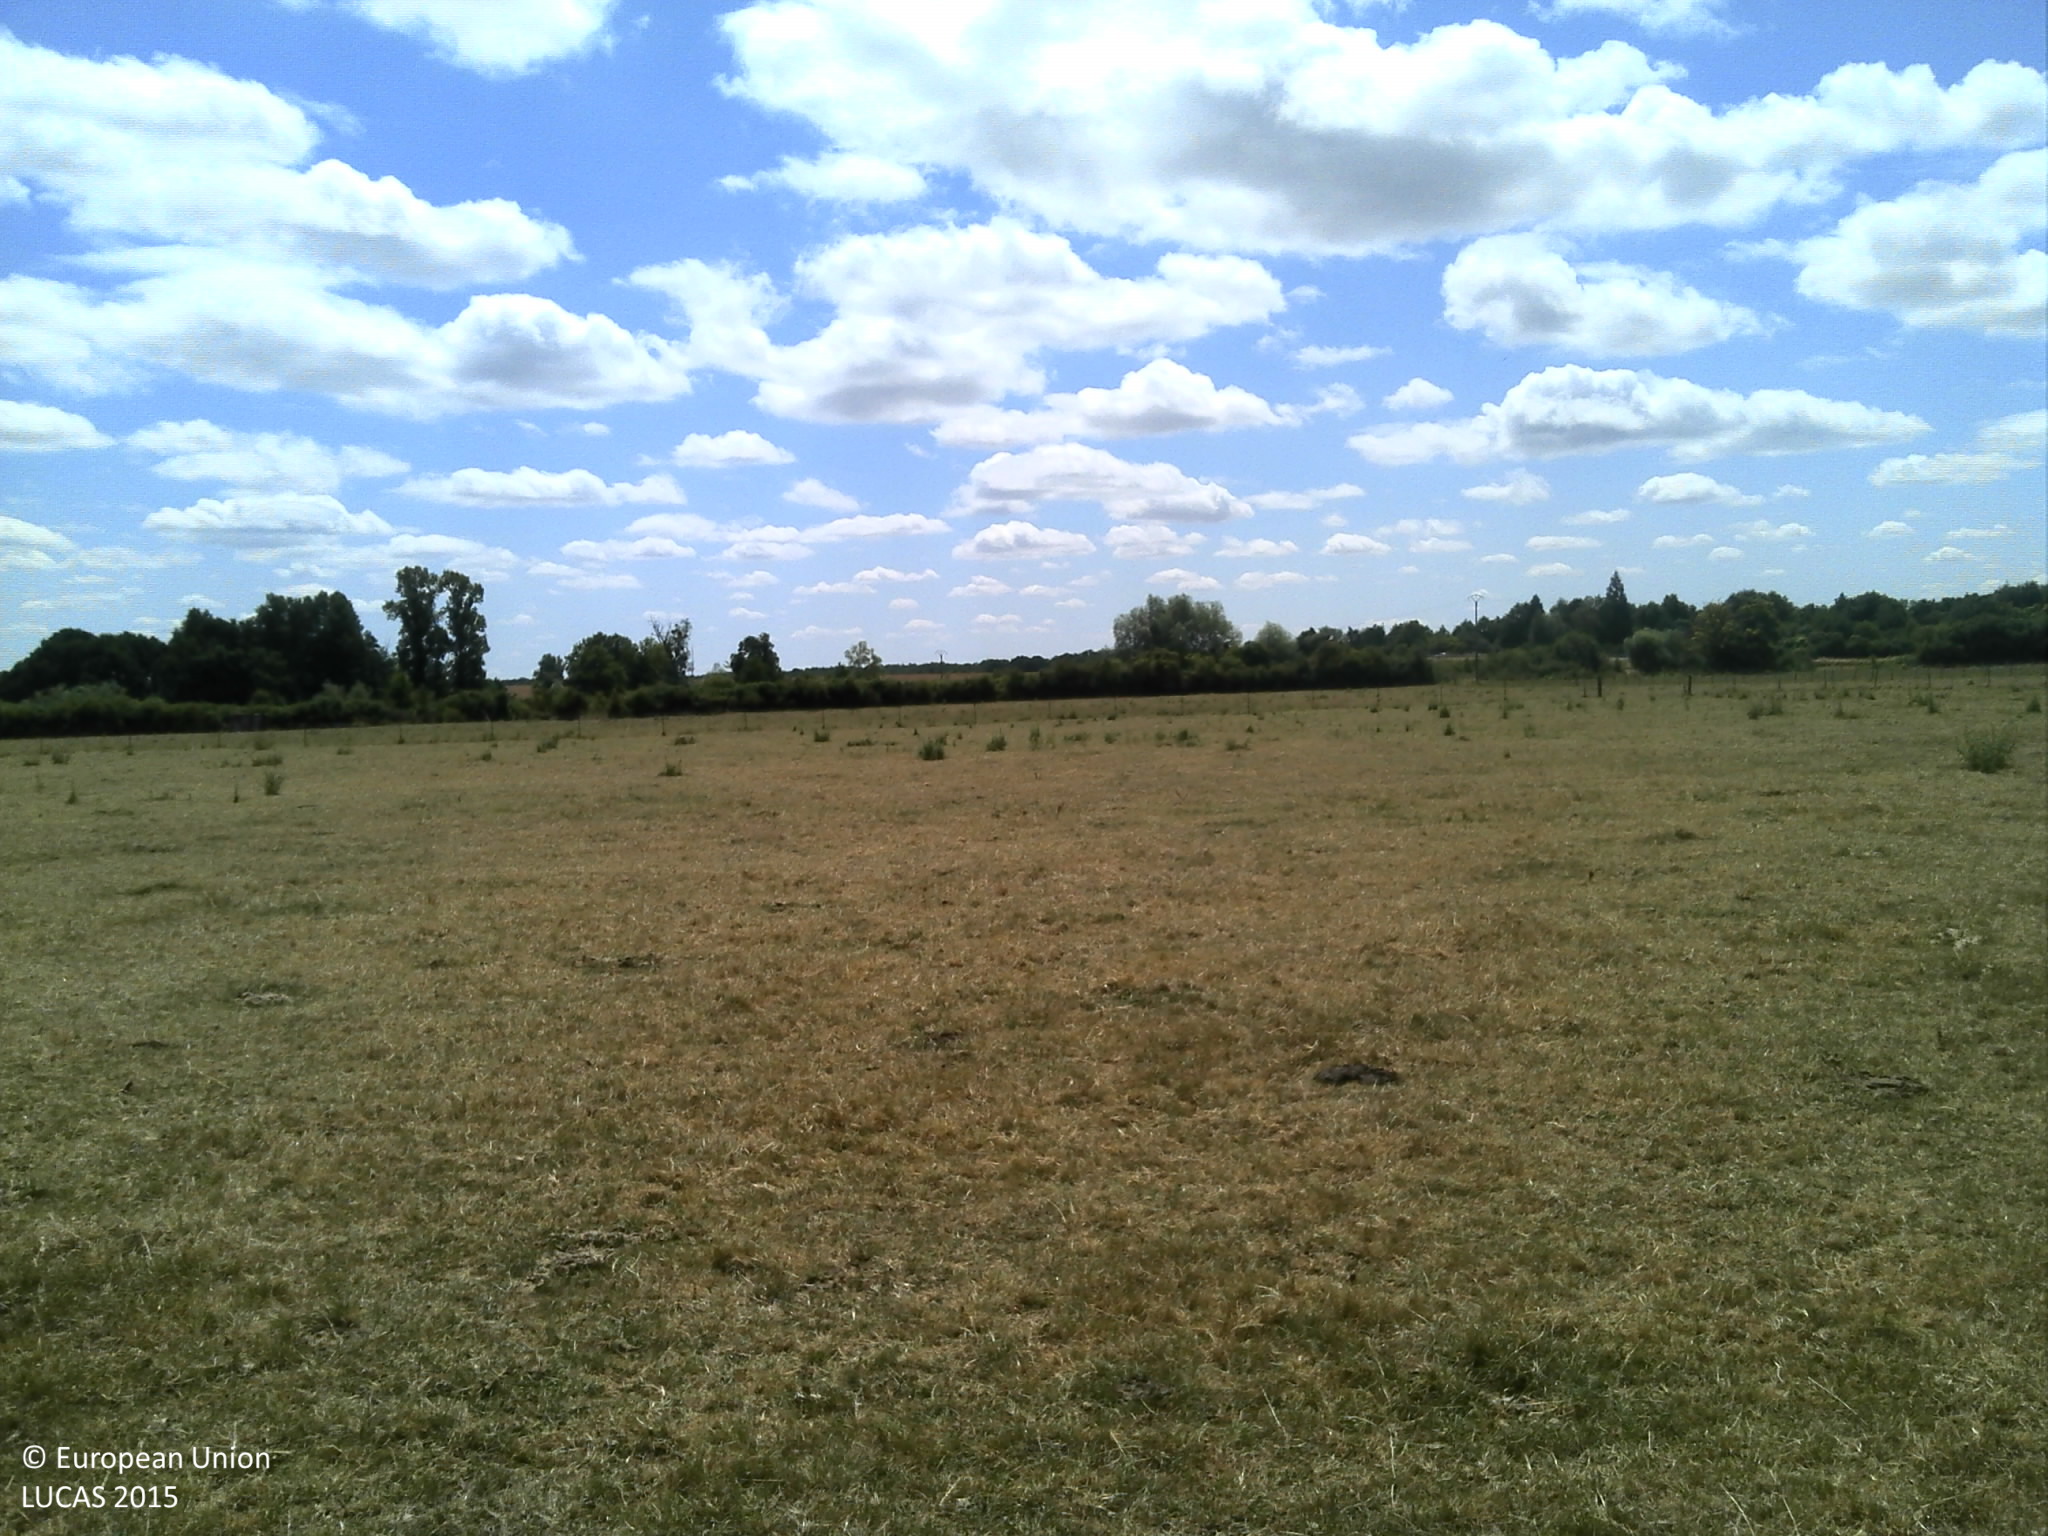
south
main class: Grassland
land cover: Grassland without tree/shrub cover
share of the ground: > 75 %
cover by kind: herbaceous plants 100 %
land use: Agriculture (excluding fallow land and kitchen gardens)
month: July
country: FR
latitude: 49.3067
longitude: 4.7569
